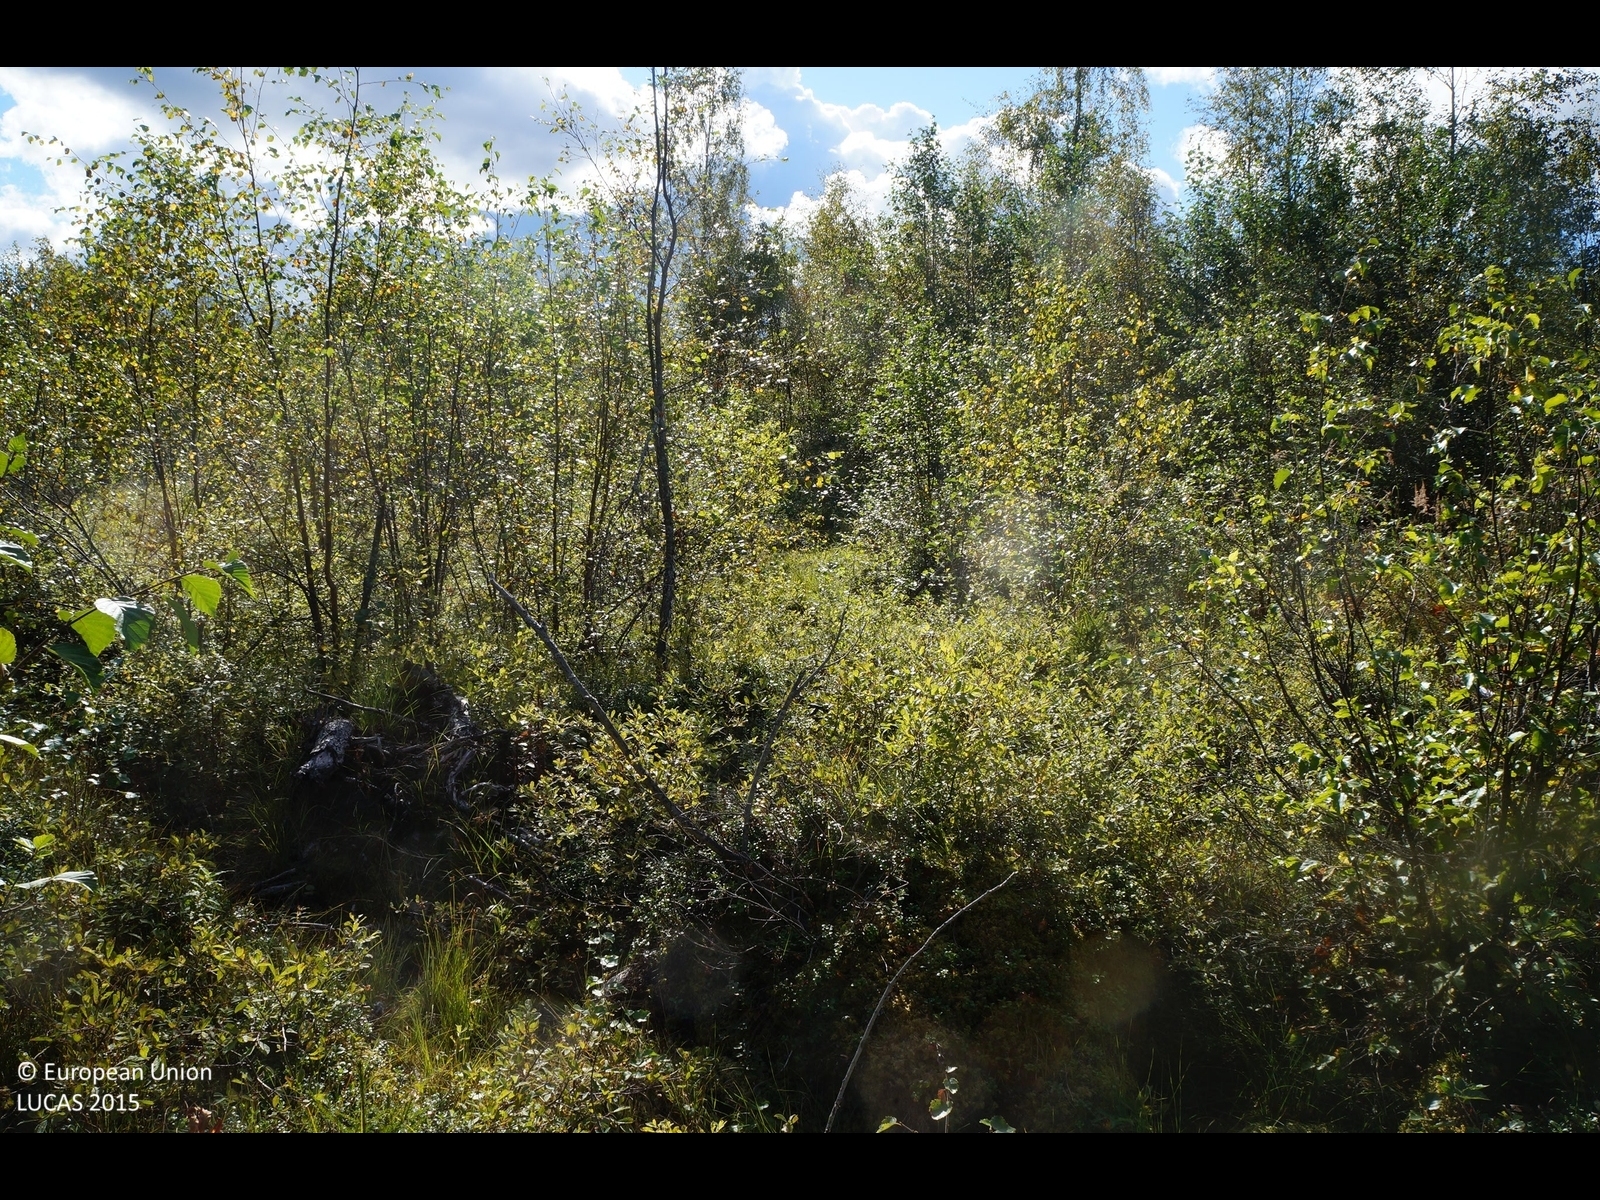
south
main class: Woodland
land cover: Broadleaved woodland
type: boreal forest
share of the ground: 25 - 50 %
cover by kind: shrubs 60 %, broadleaved forest trees 25 %, lichens and mosses 10 %, herbaceous plants 5 %
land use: Forestry
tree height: < 5 m
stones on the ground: < 10 %
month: September
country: FI
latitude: 63.9629
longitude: 24.3448
